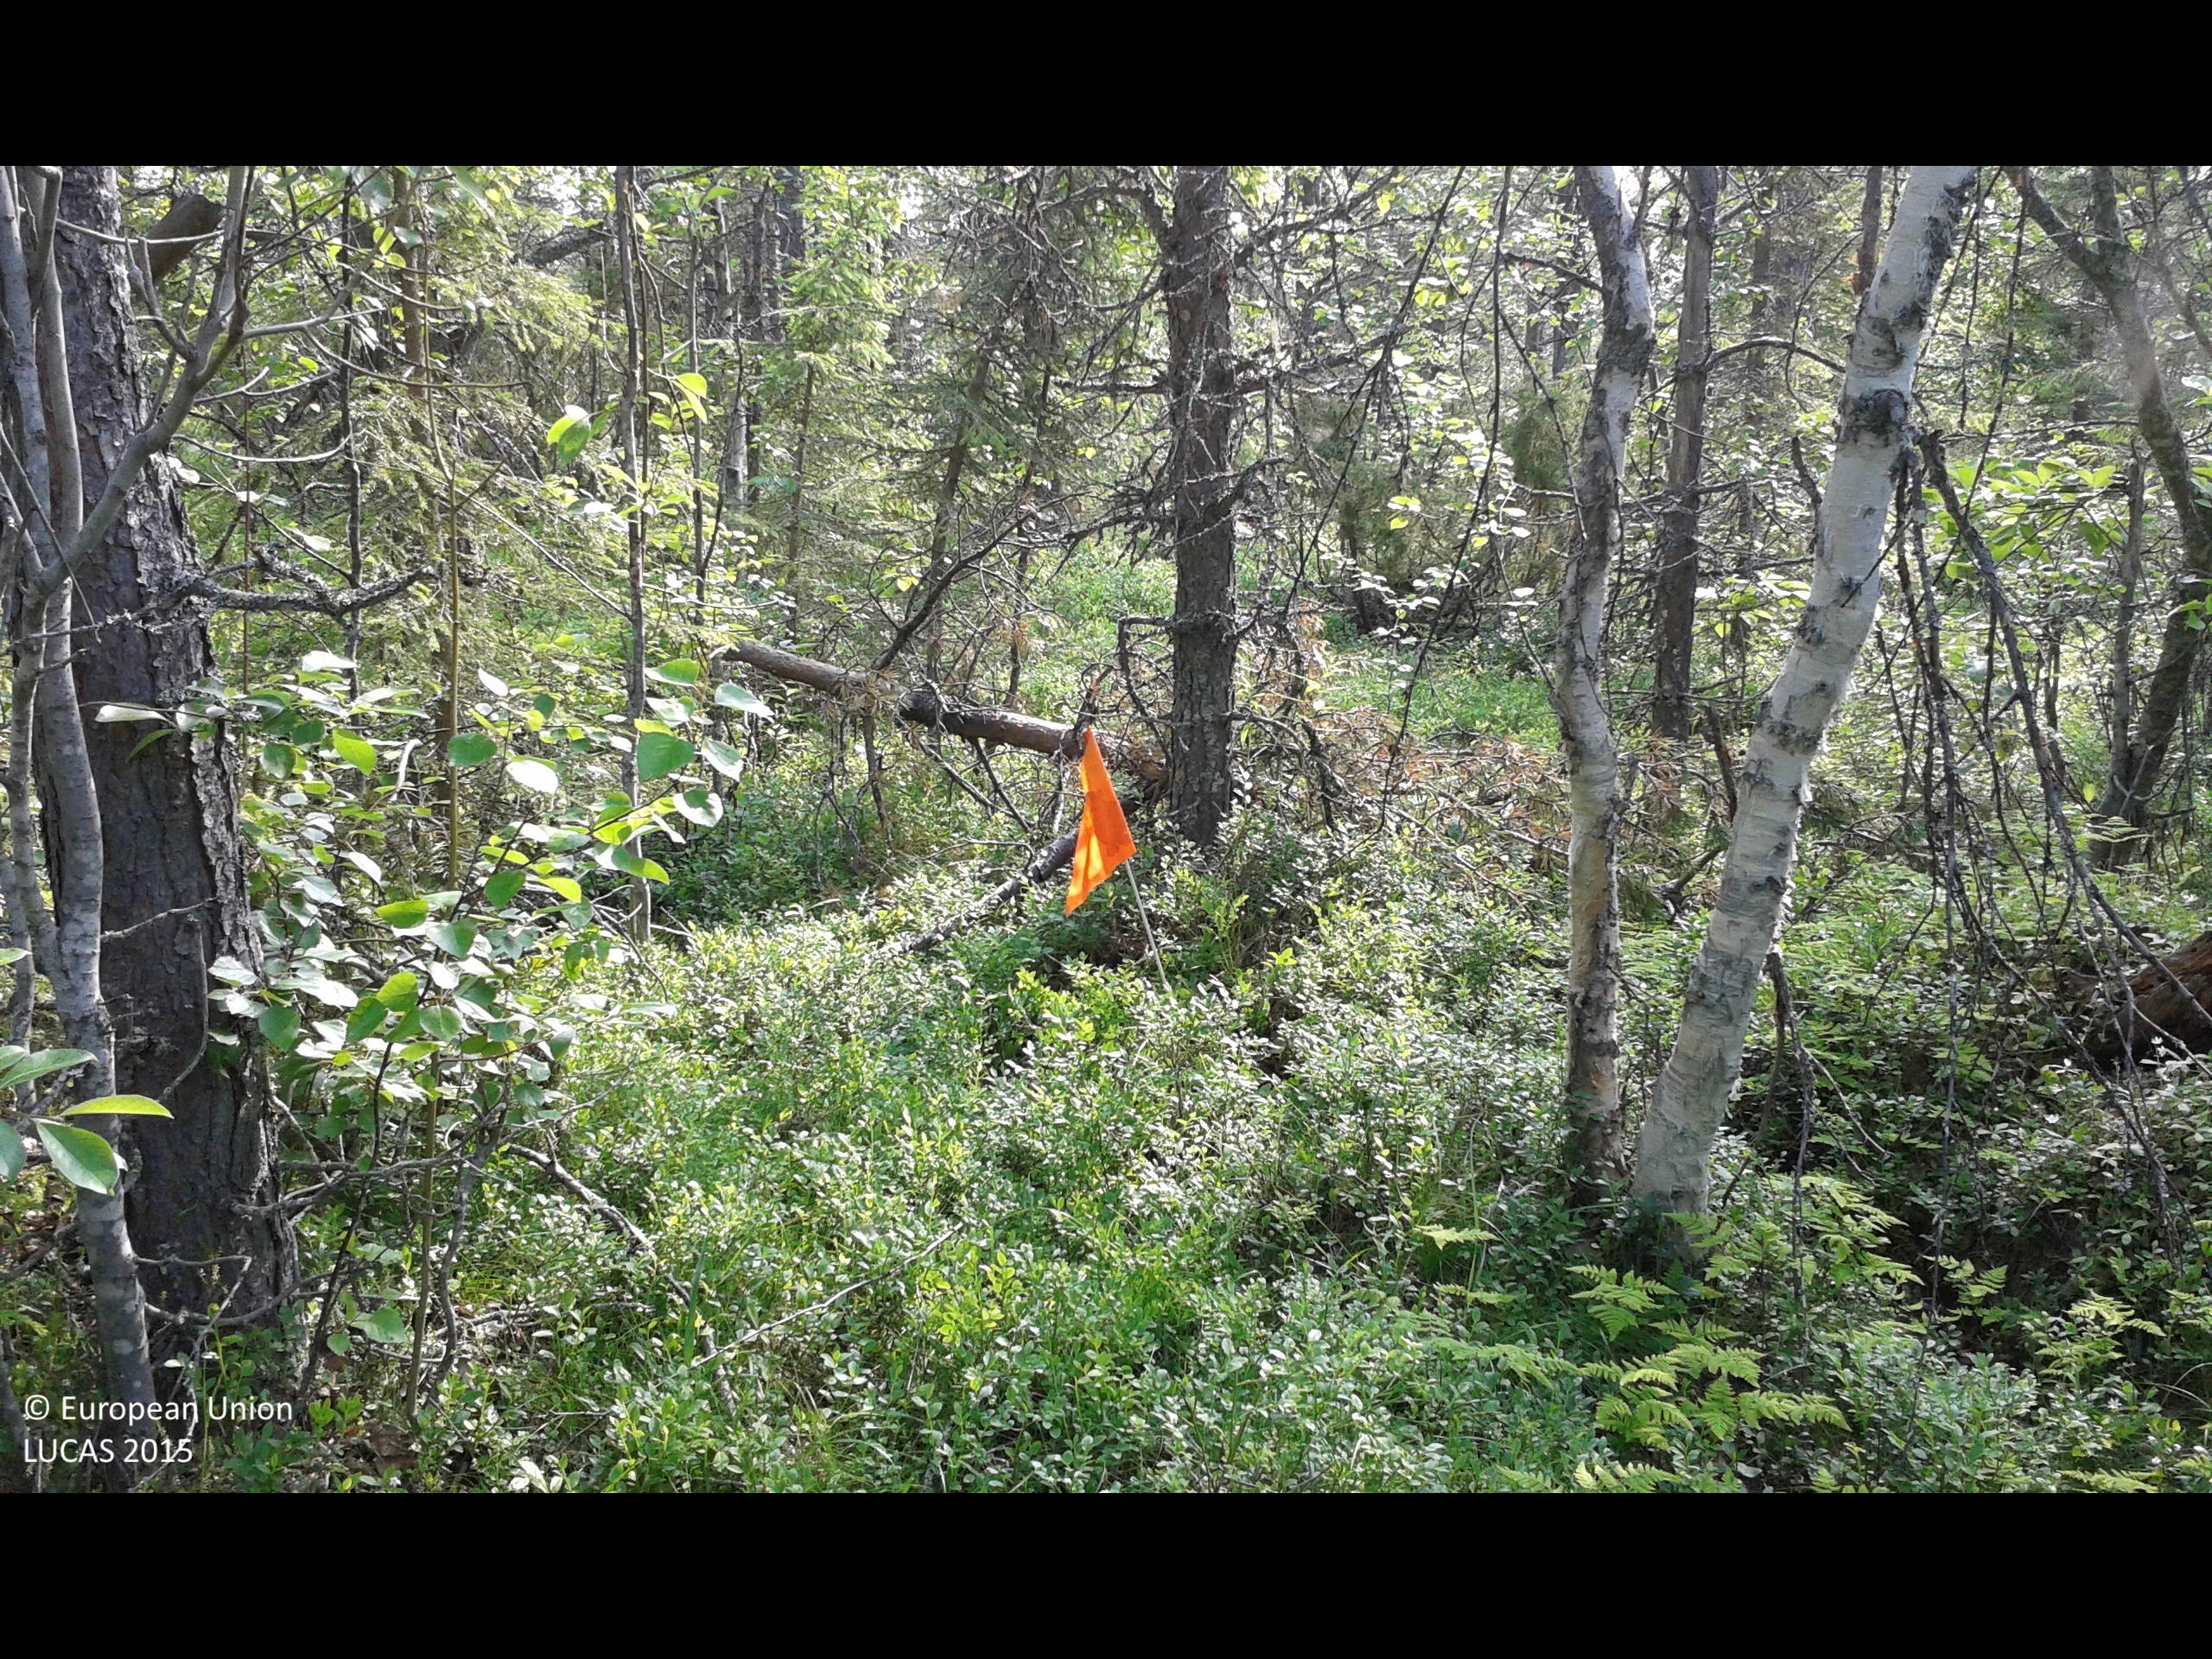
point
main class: Woodland
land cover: Pine dominated mixed woodland
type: boreal forest
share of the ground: 25 - 50 %
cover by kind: shrubs 50 %, coniferous forest trees 20 %, herbaceous plants 15 %, broadleaved forest trees 10 %, lichens and mosses 5 %
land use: Forestry
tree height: > 5 m
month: July
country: SE
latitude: 66.7492
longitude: 23.4413
